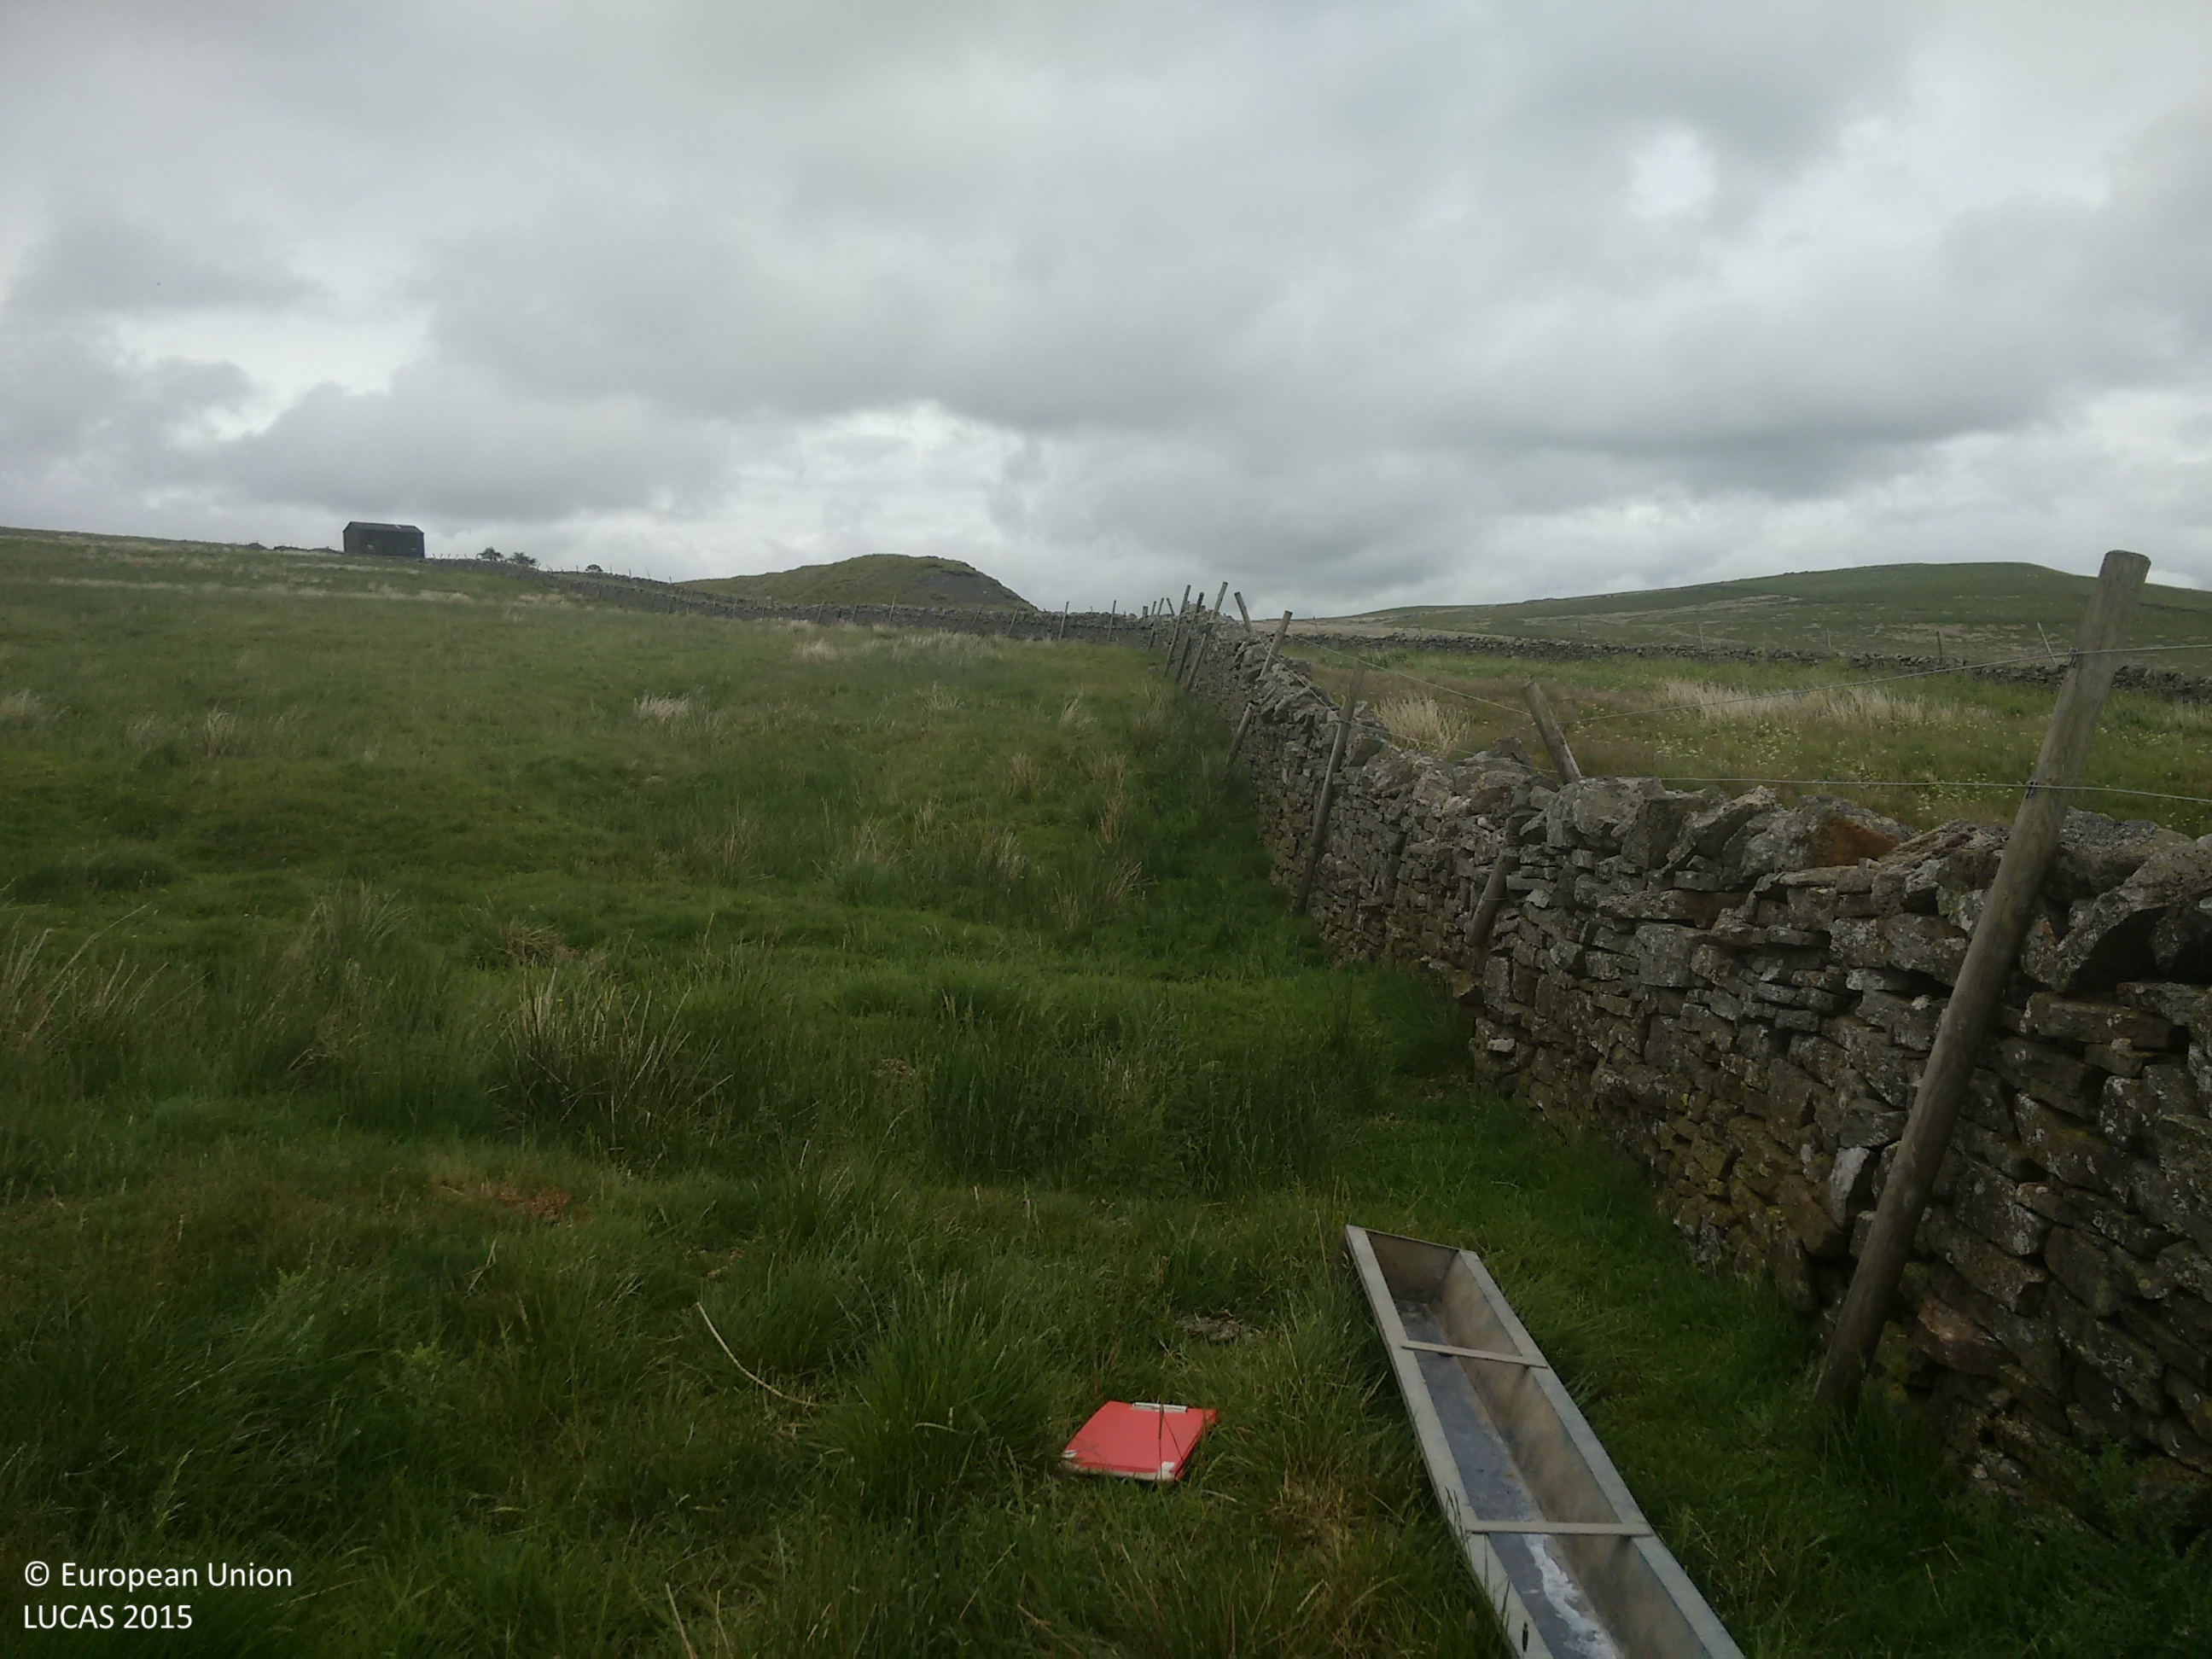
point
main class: Grassland
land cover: Grassland without tree/shrub cover
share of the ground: > 75 %
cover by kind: herbaceous plants 100 %
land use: Agriculture (excluding fallow land and kitchen gardens)
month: June
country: GB
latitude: 54.7482
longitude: -2.1916
